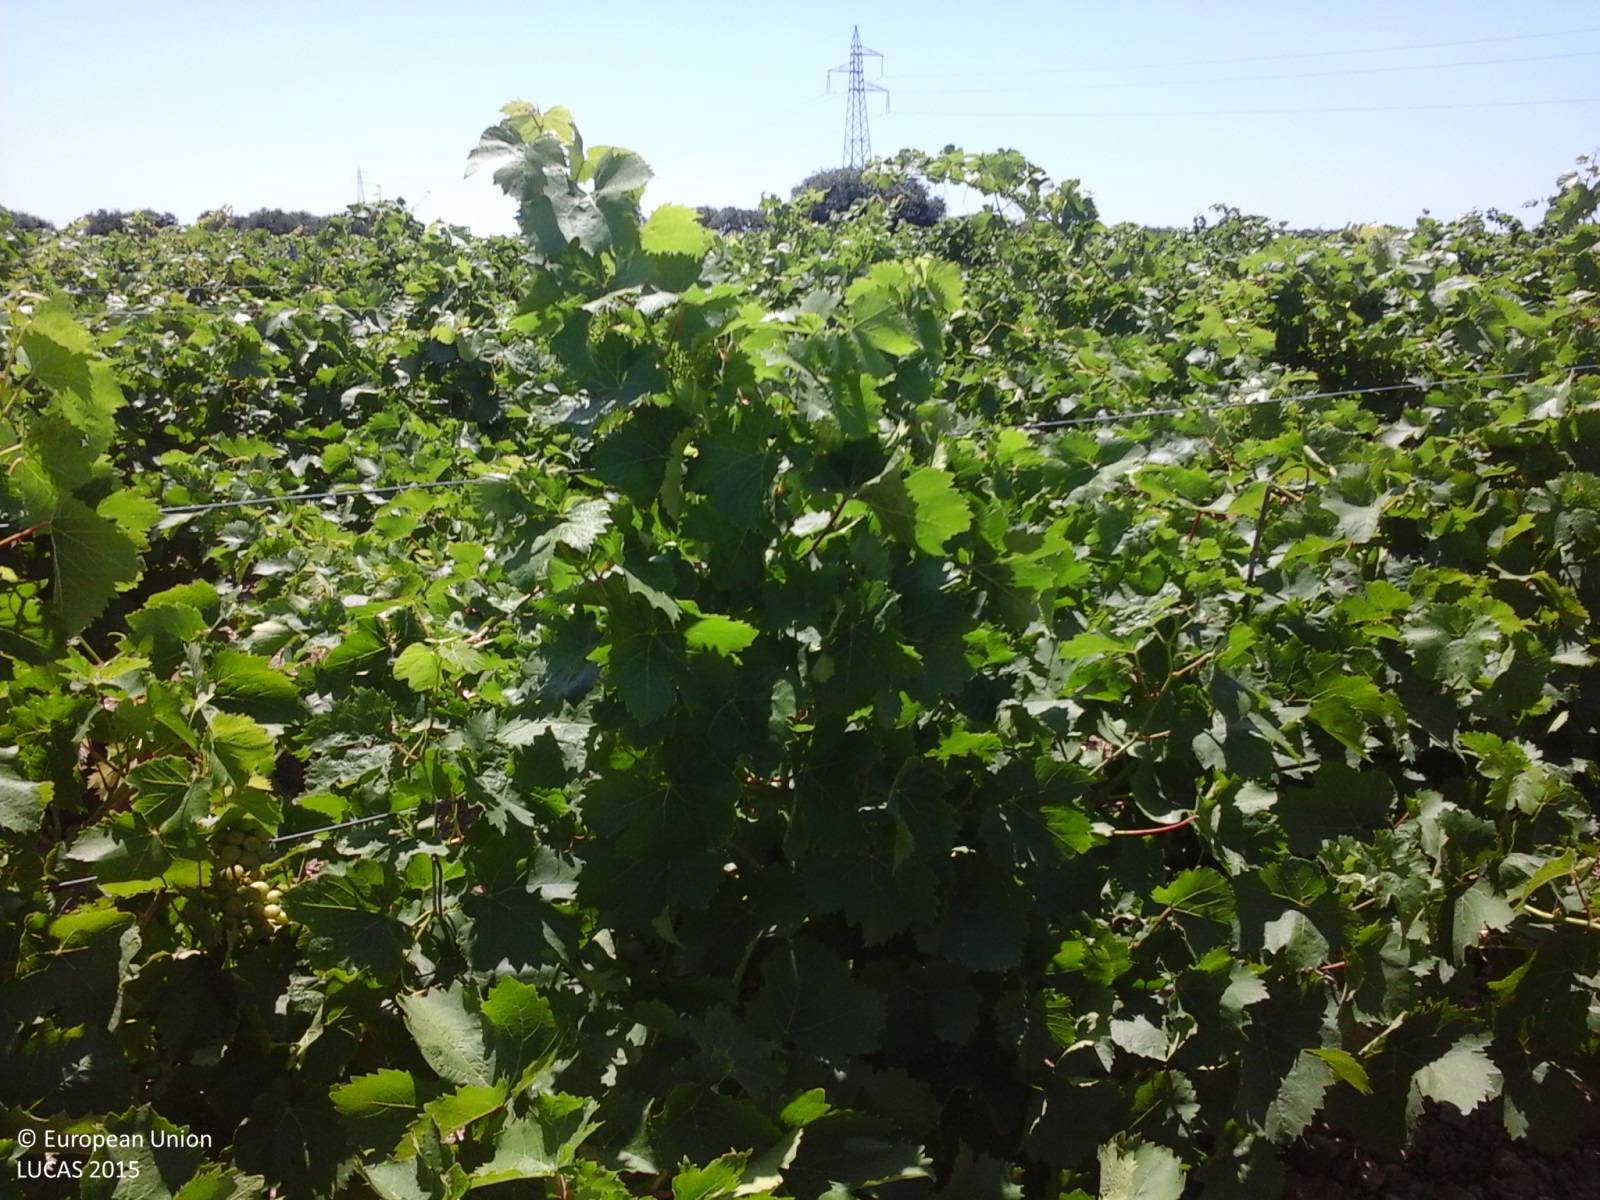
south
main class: Cropland
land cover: Vineyards
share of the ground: 50 - 75 %
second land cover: Other bare soil
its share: > 75 %
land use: Agriculture (excluding fallow land and kitchen gardens)
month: July
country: IT
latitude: 37.7670
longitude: 12.5803
